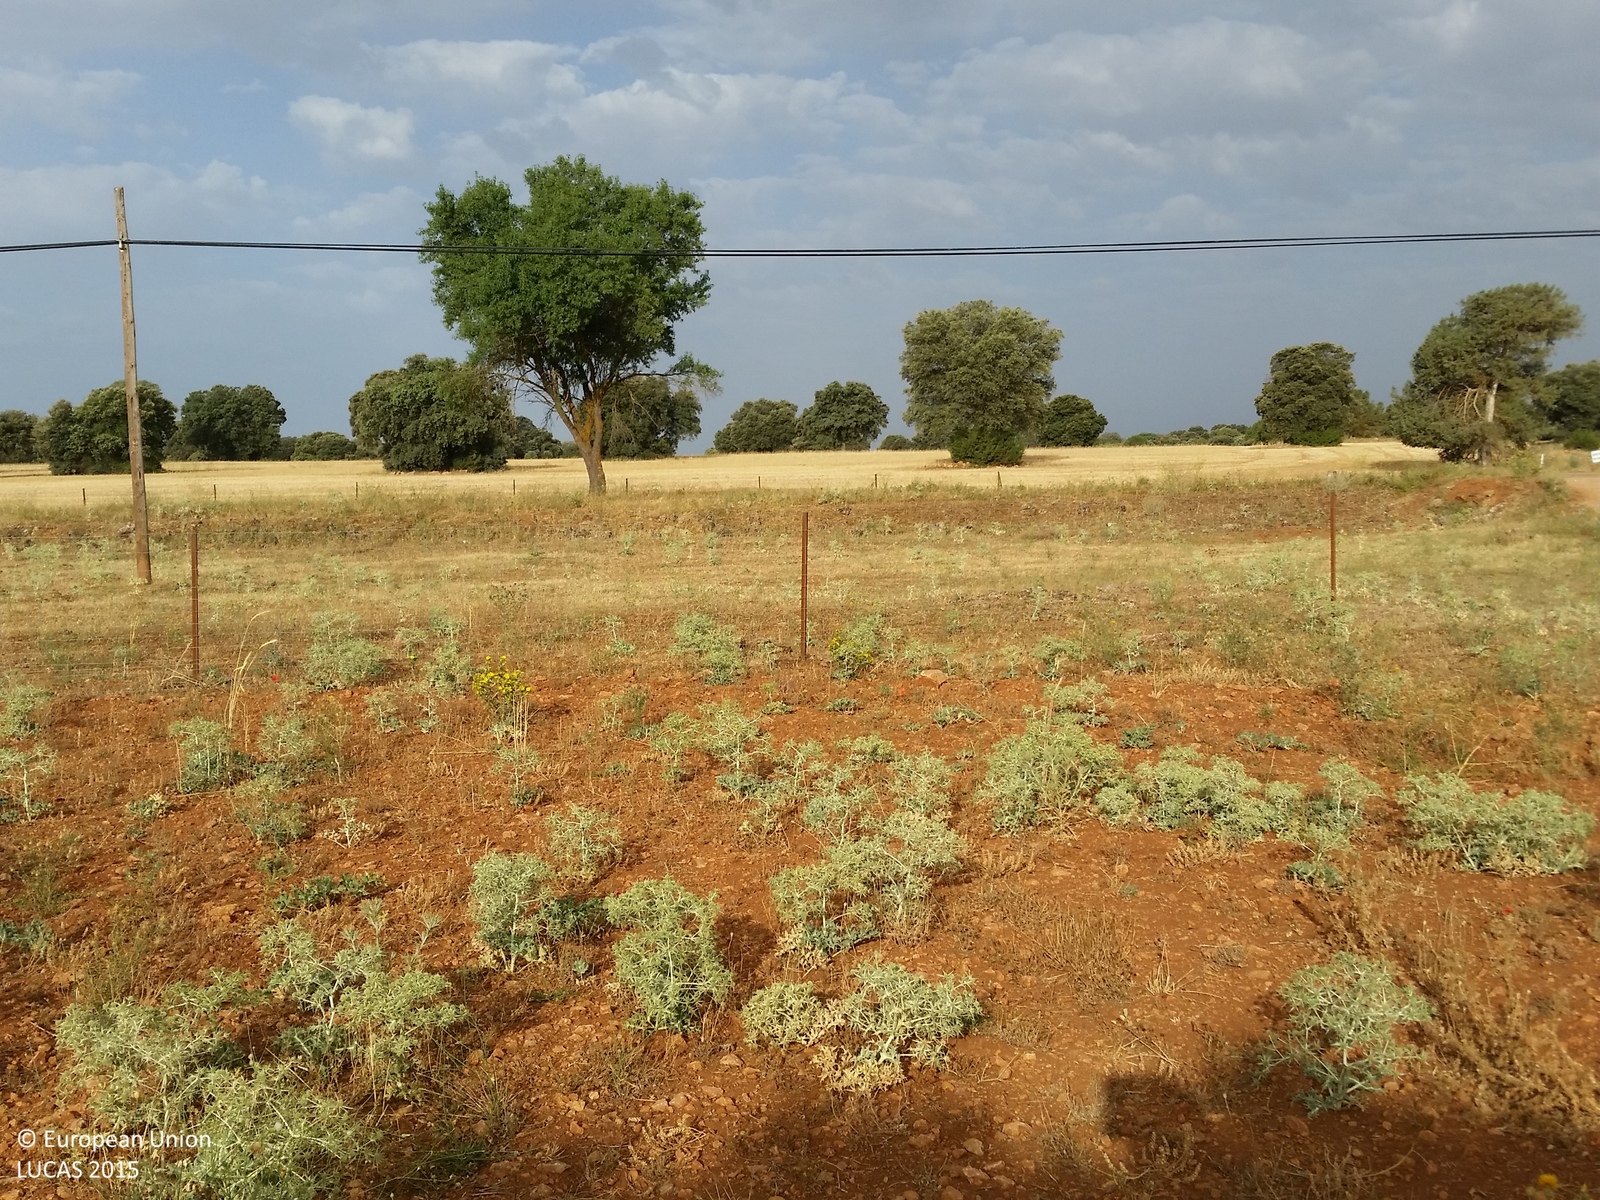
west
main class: Woodland
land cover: Broadleaved woodland
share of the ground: 50 - 75 %
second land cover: Spontaneously vegetated surfaces
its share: 25 - 50 %
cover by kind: broadleaved forest trees 60 %, herbaceous plants 30 %, unconsolidated bare surface 10 %
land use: Forestry
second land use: Fallow land
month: July
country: ES
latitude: 38.7438
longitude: -2.5550
